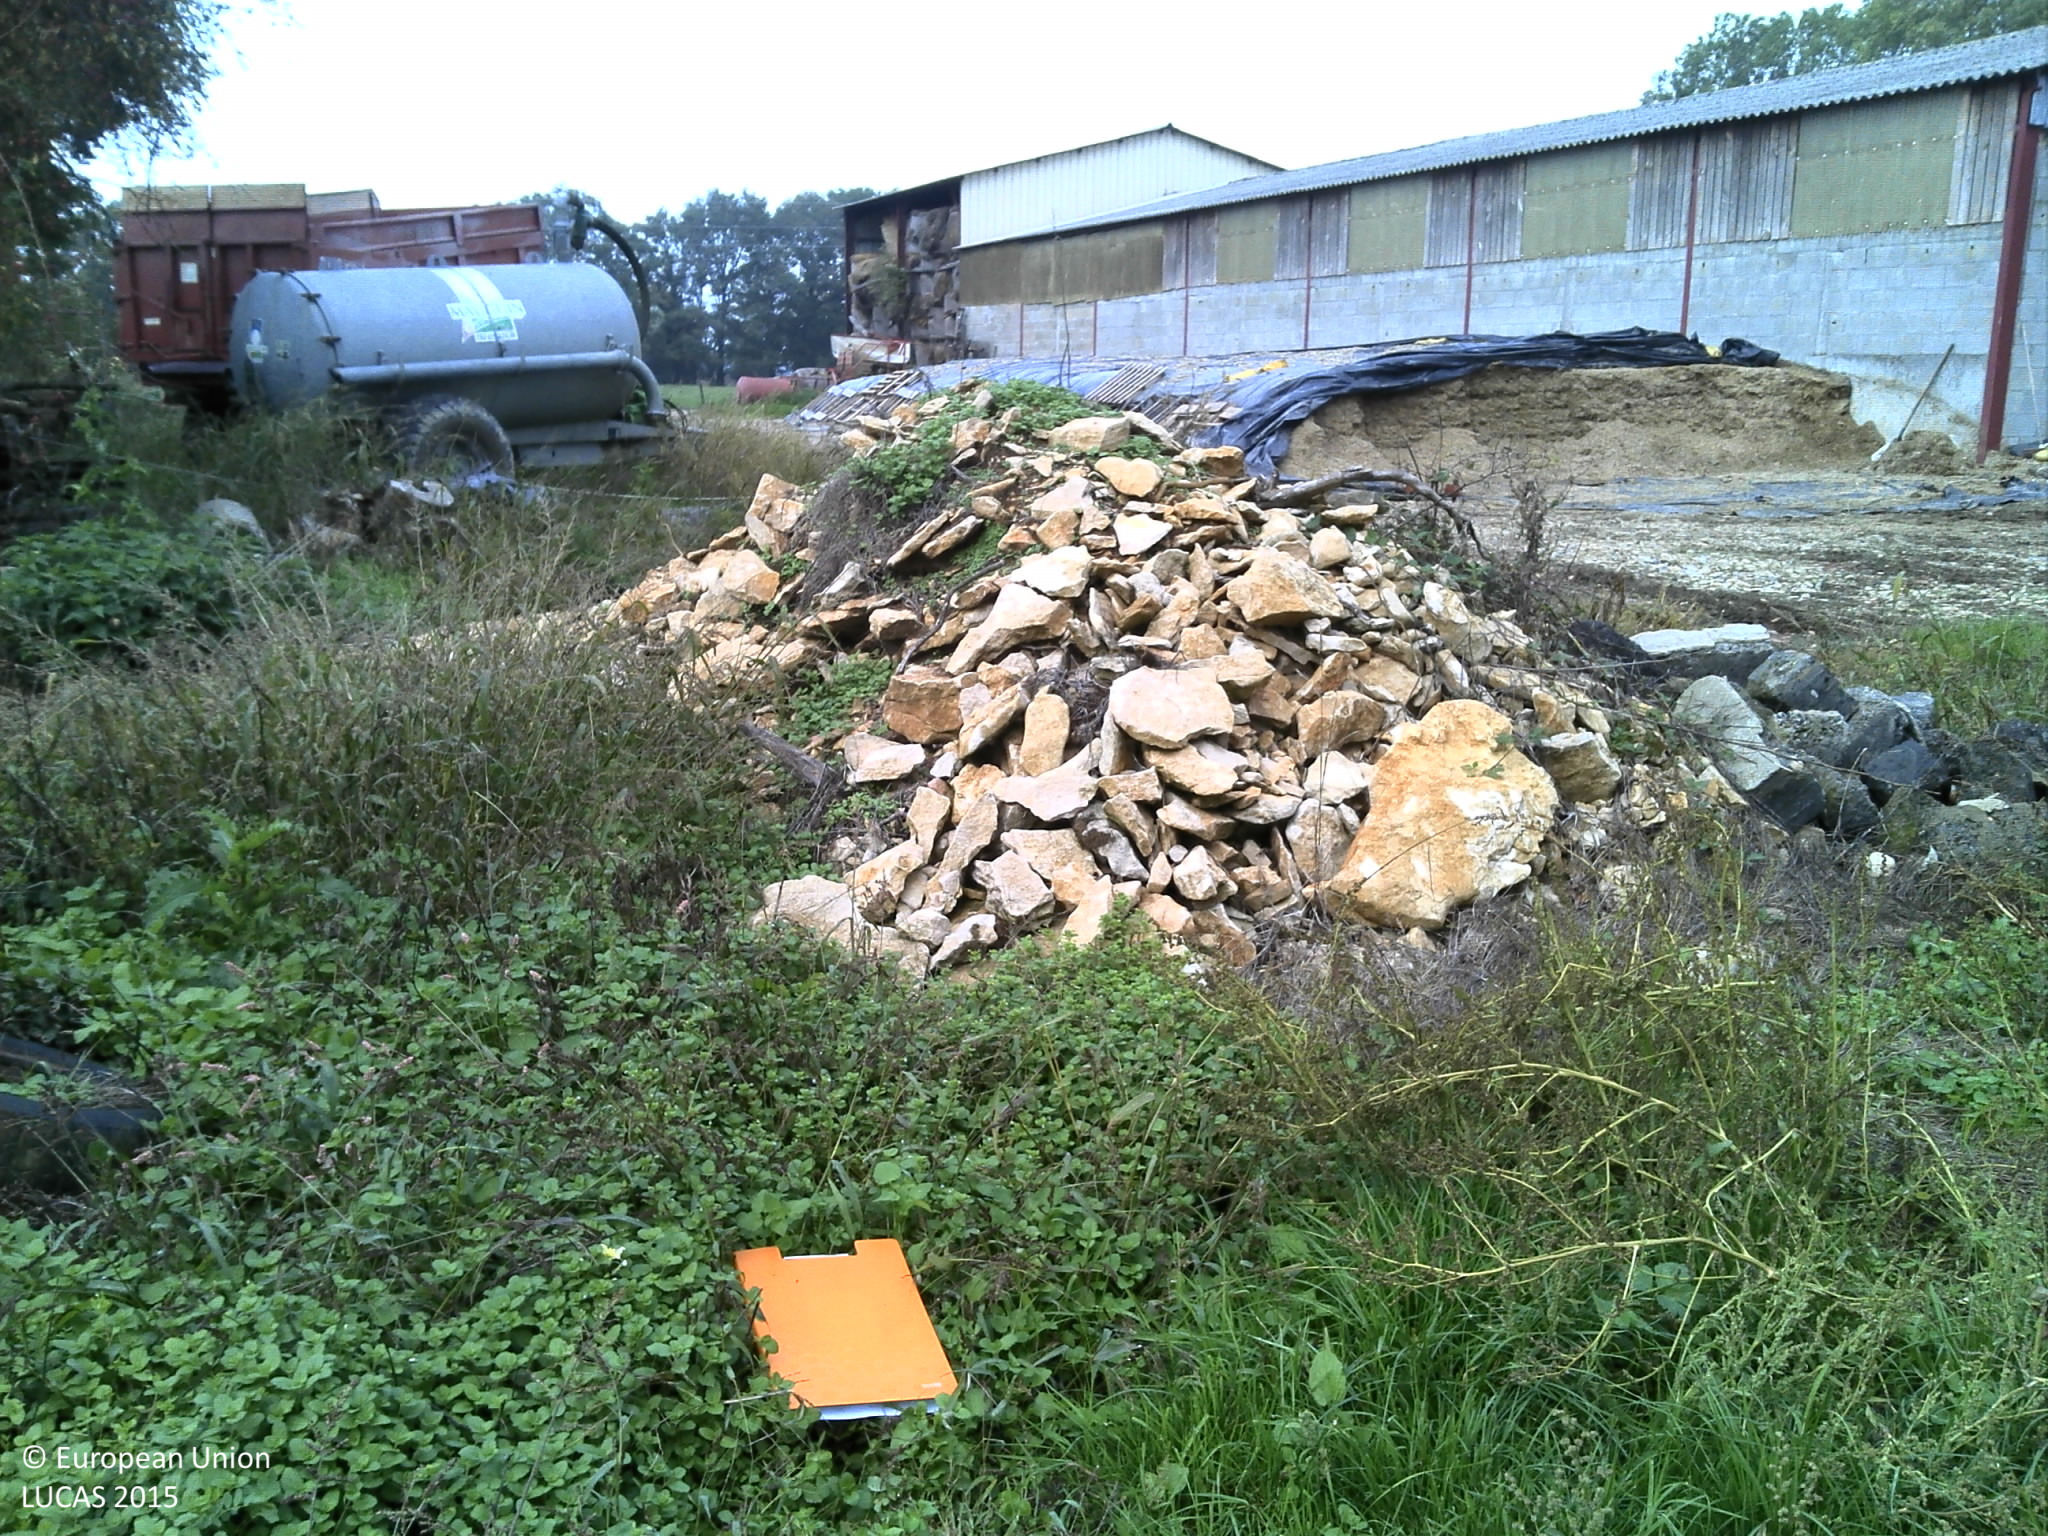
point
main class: Grassland
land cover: Spontaneously vegetated surfaces
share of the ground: > 75 %
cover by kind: herbaceous plants 100 %
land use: Semi-natural and natural areas not in use
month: October
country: FR
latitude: 46.3028
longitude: 5.3158
